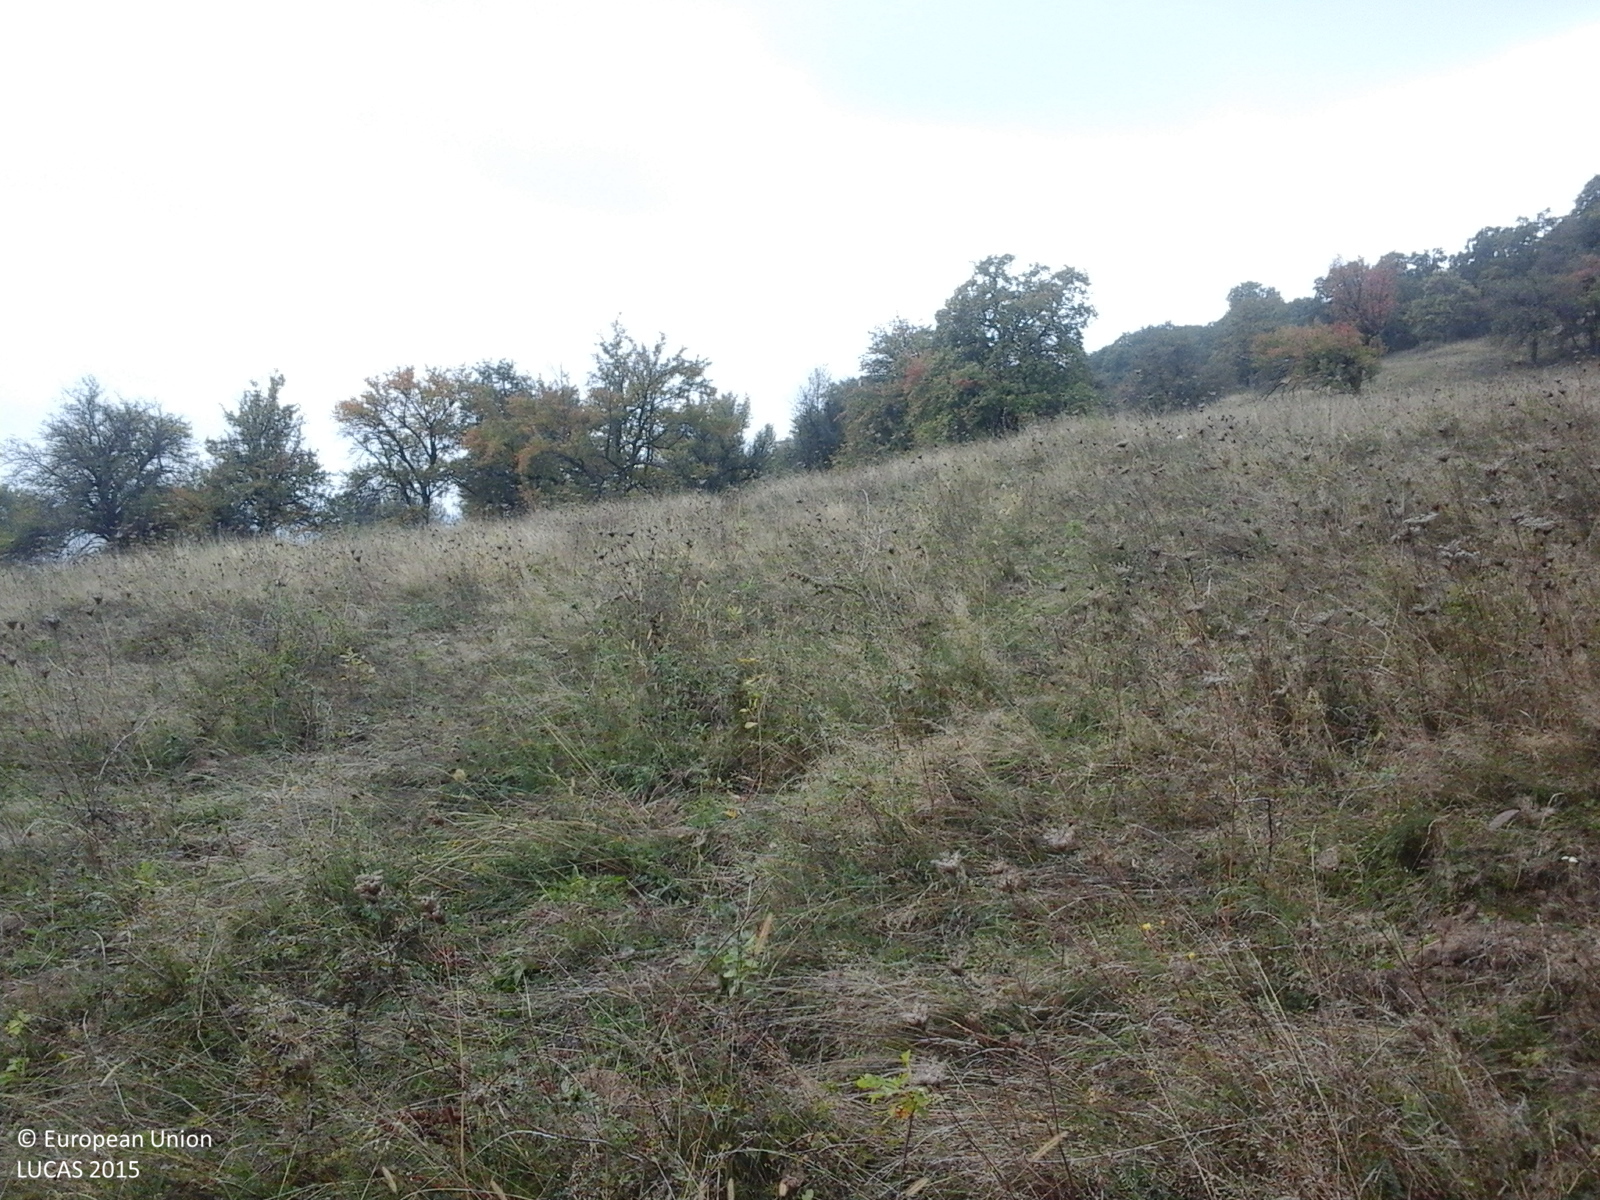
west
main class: Grassland
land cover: Grassland with sparse tree/shrub cover
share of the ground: > 75 %
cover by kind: herbaceous plants 85 %, shrubs 10 %, broadleaved forest trees 5 %
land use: Fallow land
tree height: < 5 m
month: October
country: RO
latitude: 46.0760
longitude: 25.1086
